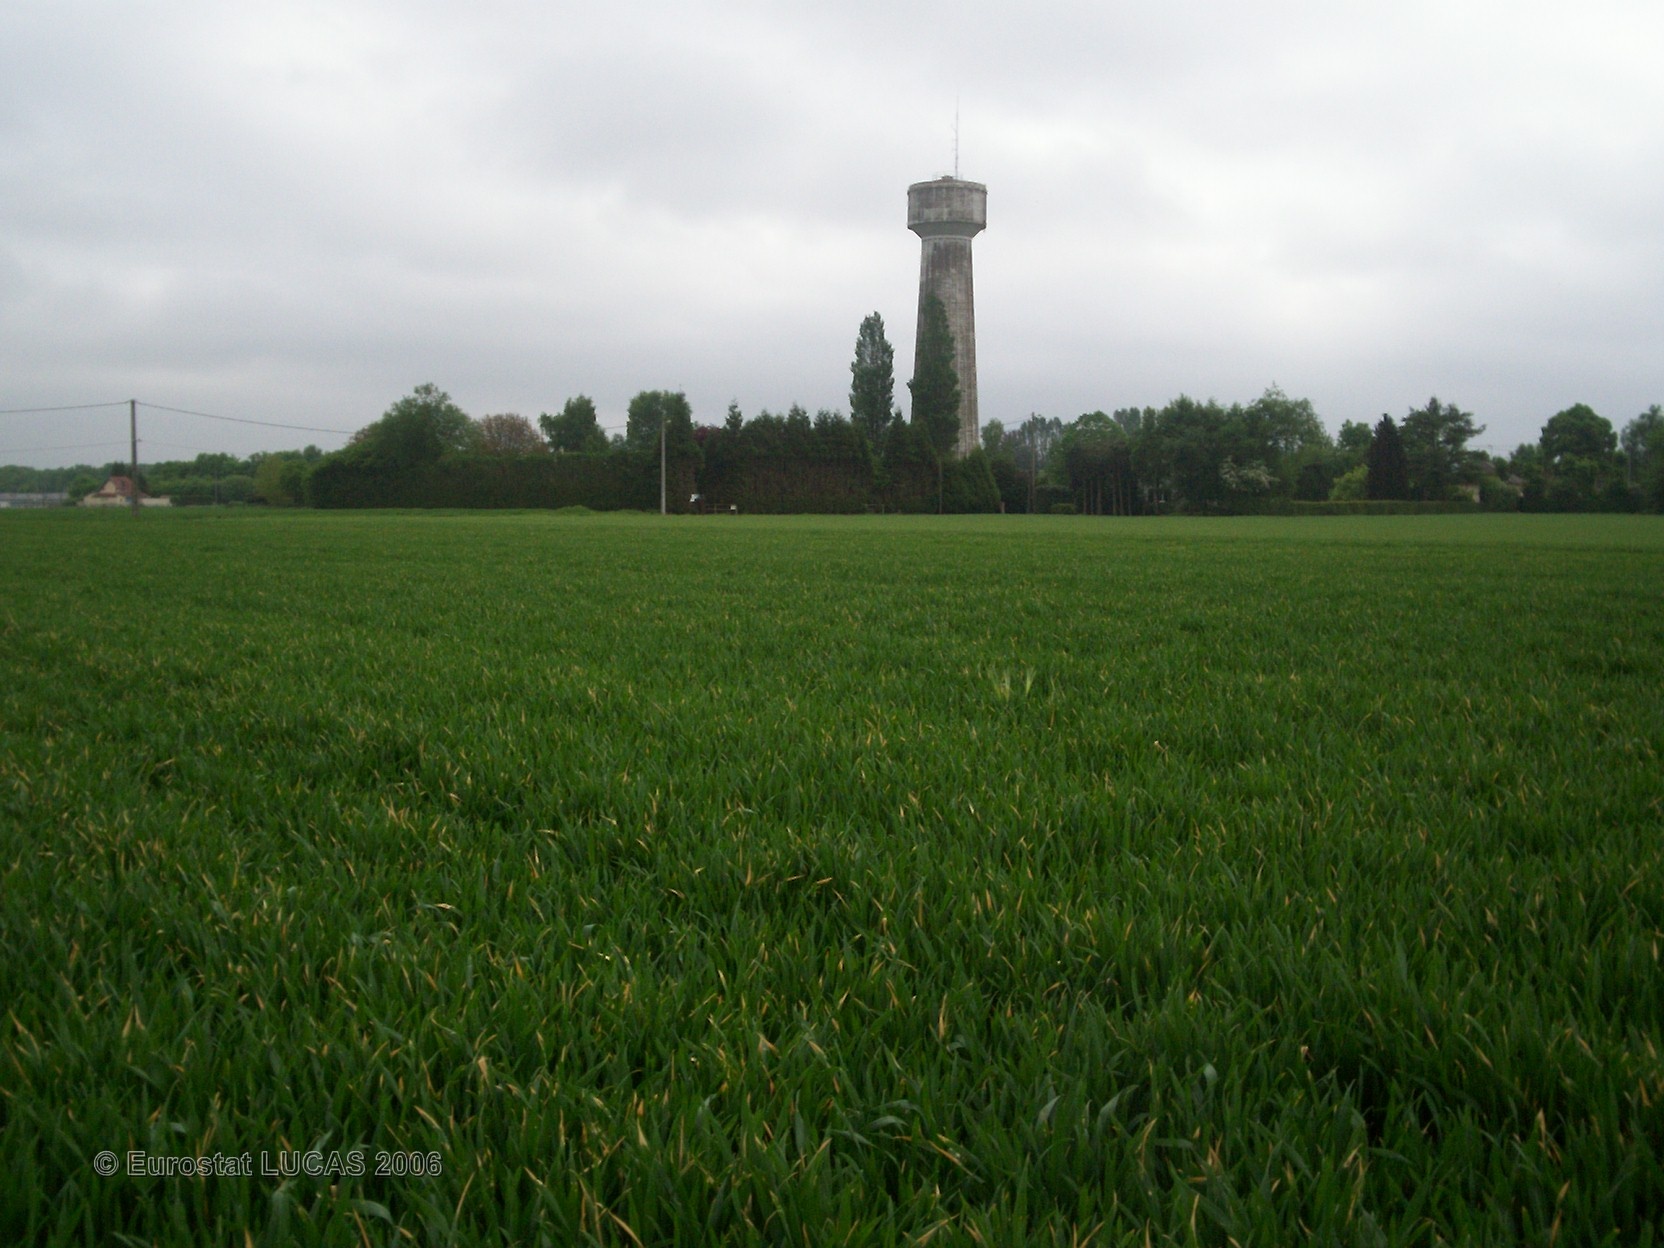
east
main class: Cropland
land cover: Common wheat
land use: Agriculture (excluding fallow land and kitchen gardens)
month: May
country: FR
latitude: 49.2648
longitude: 0.9768
